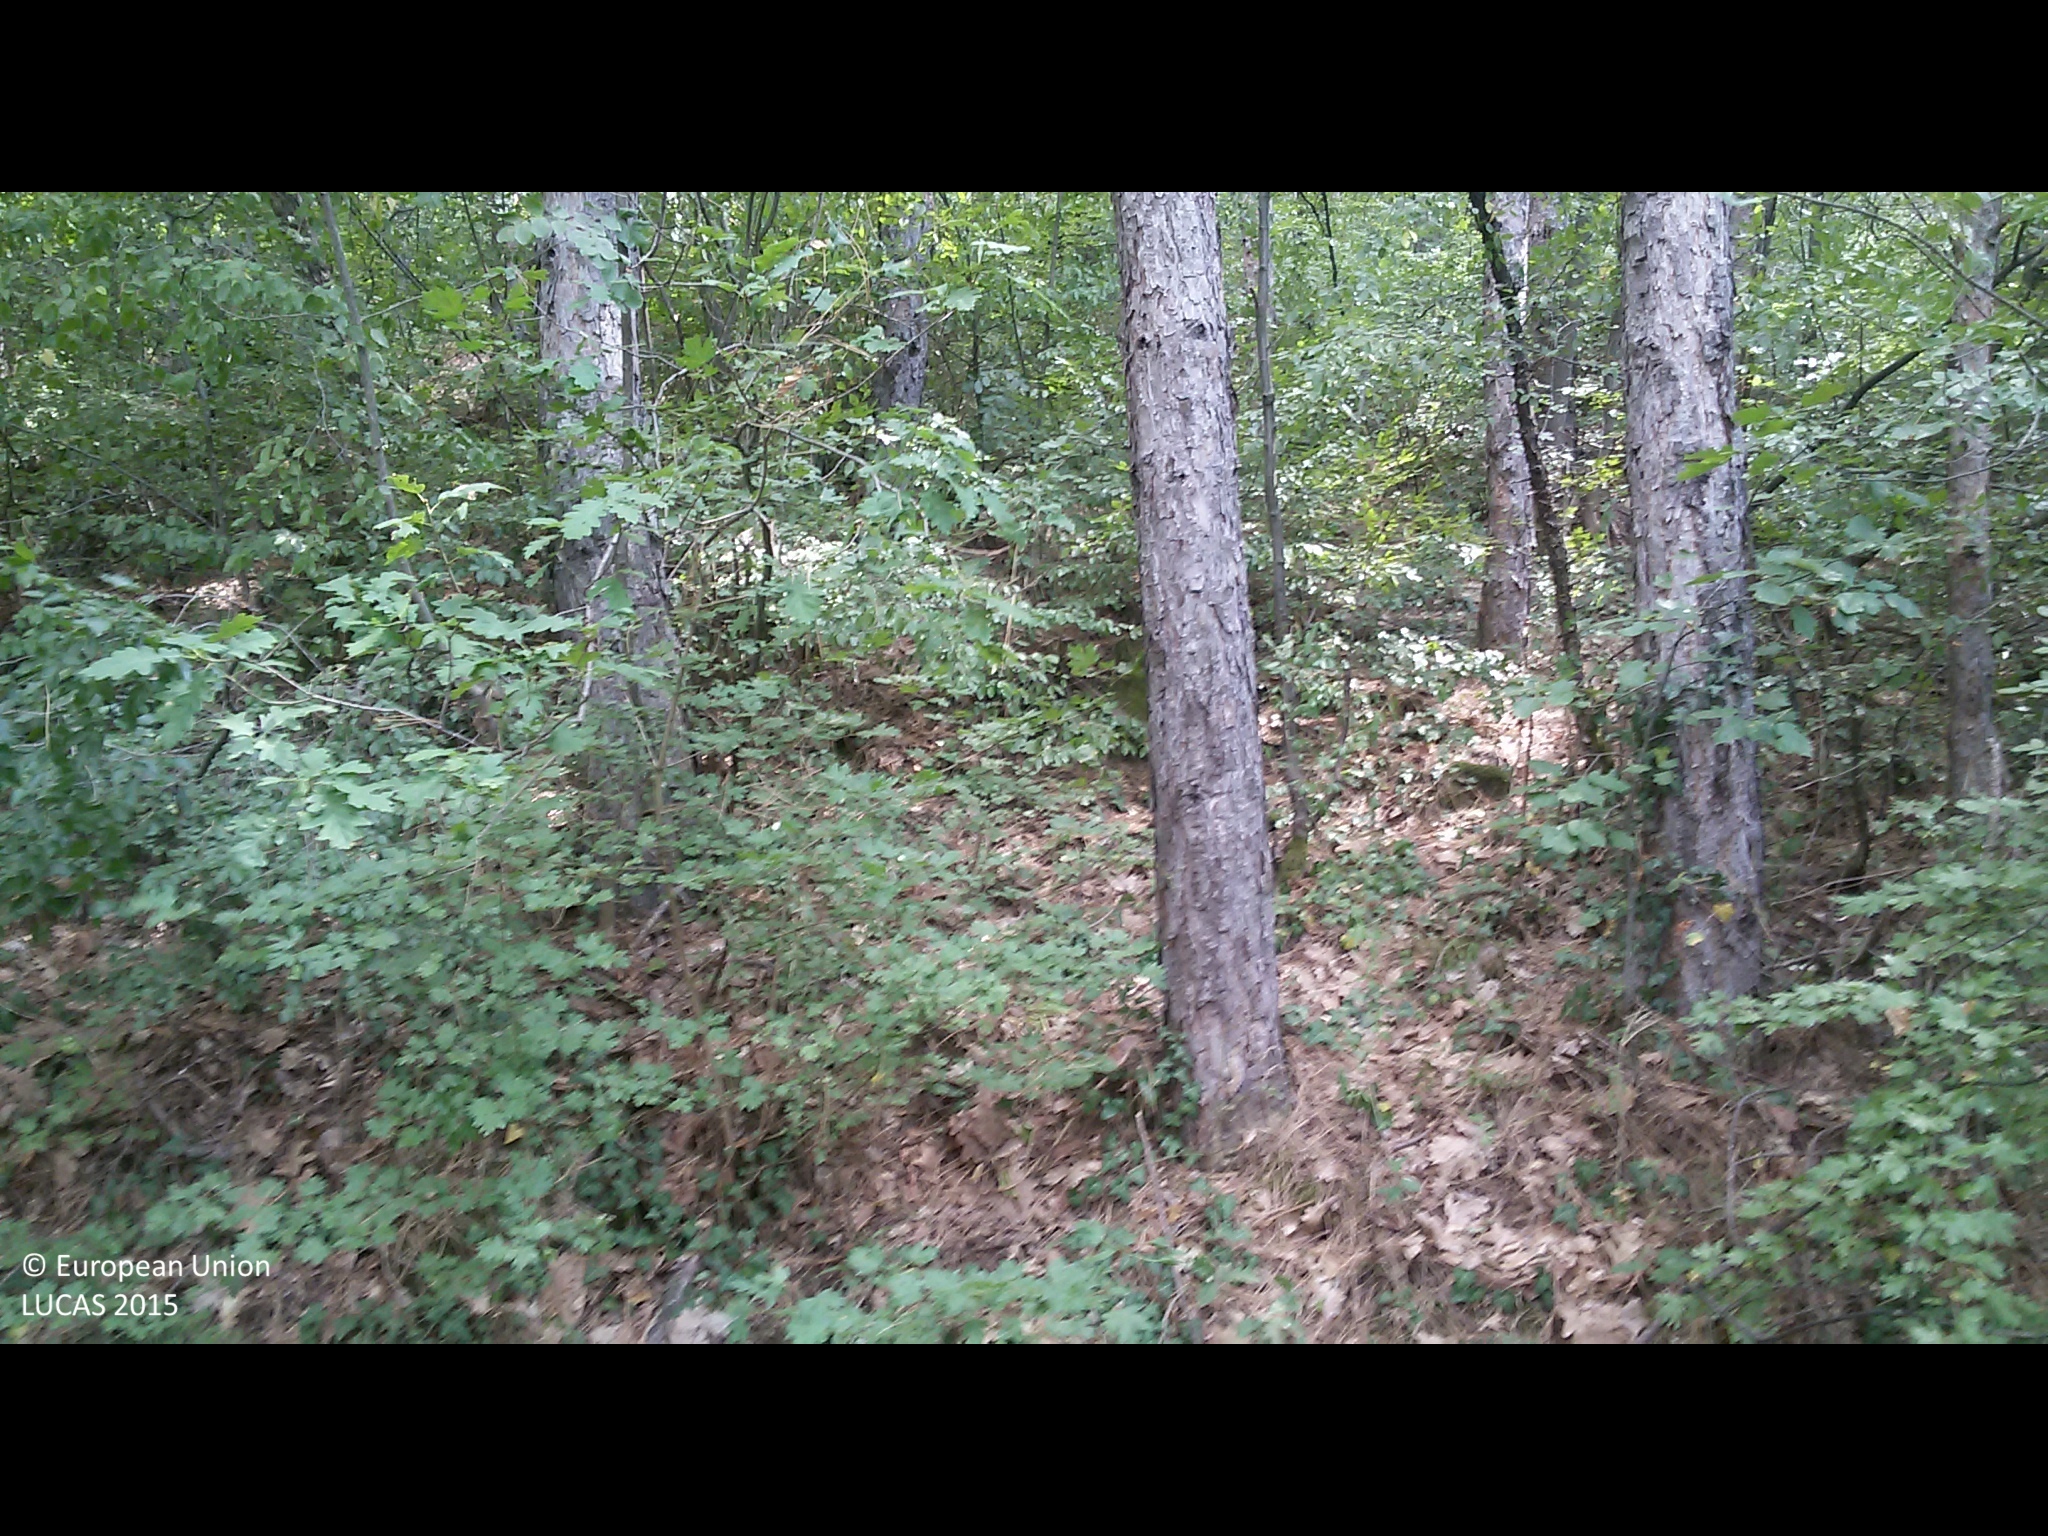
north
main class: Woodland
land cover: Broadleaved woodland
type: mesophytic deciduous forest
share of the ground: > 75 %
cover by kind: broadleaved forest trees 95 %, coniferous forest trees 5 %
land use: Forestry
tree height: > 5 m
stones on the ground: < 10 %
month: August
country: BG
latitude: 42.0327
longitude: 23.1306
